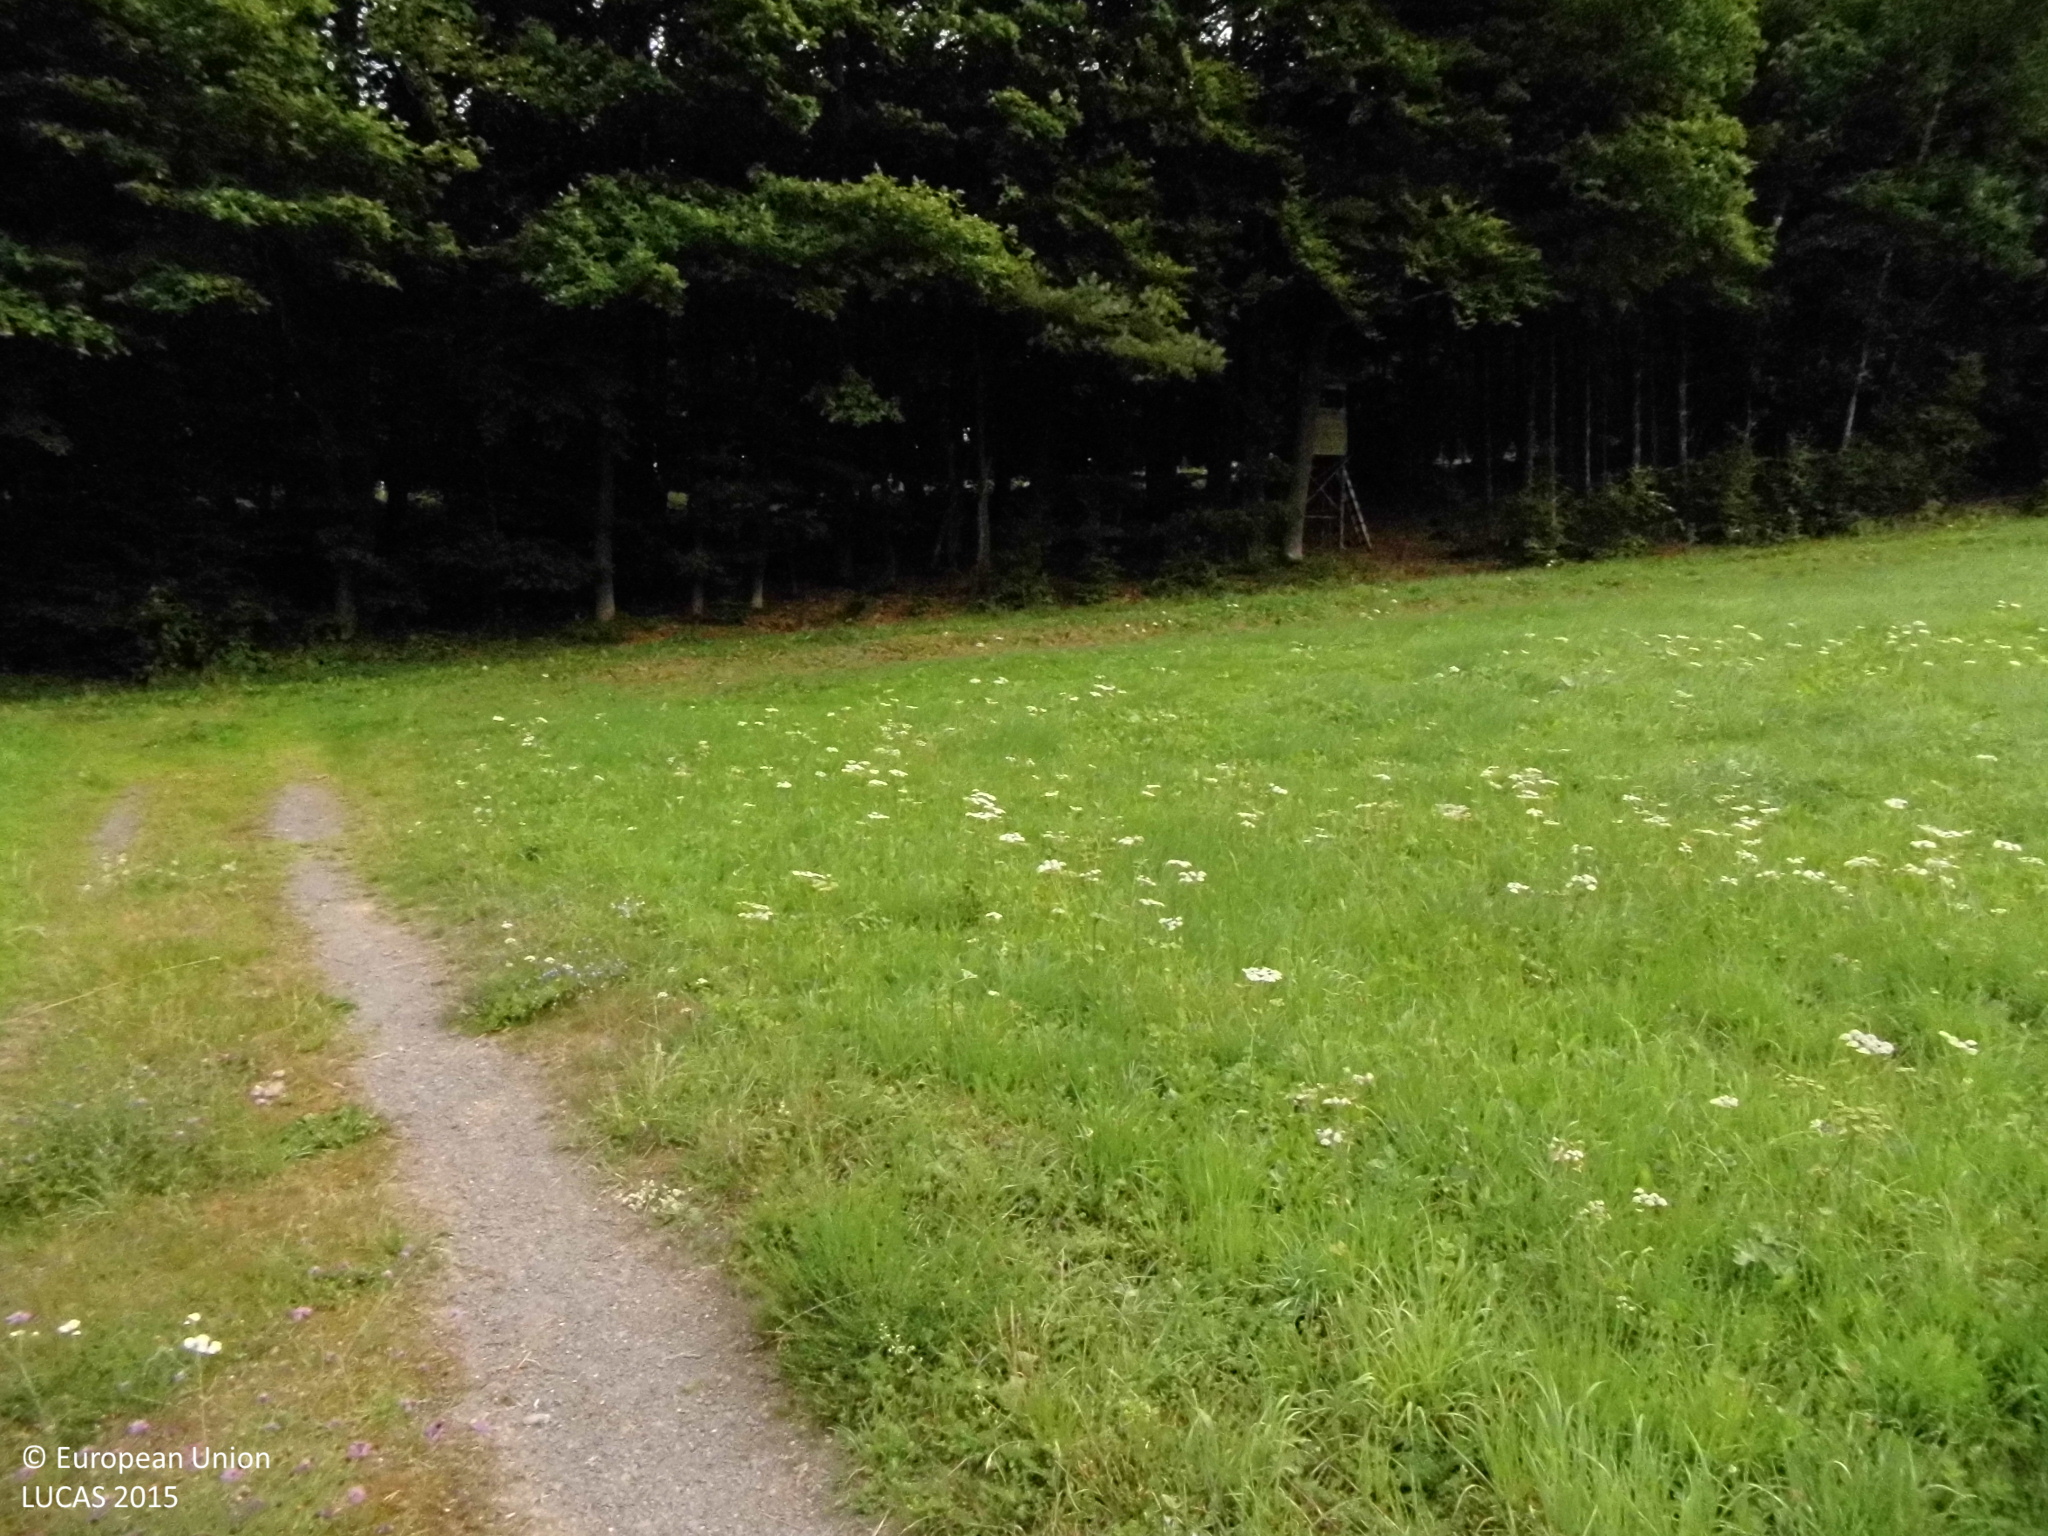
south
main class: Grassland
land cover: Grassland without tree/shrub cover
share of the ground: > 75 %
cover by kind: herbaceous plants 95 %, shrubs 5 %
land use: Agriculture (excluding fallow land and kitchen gardens)
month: August
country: DE
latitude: 50.7691
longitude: 8.5966
